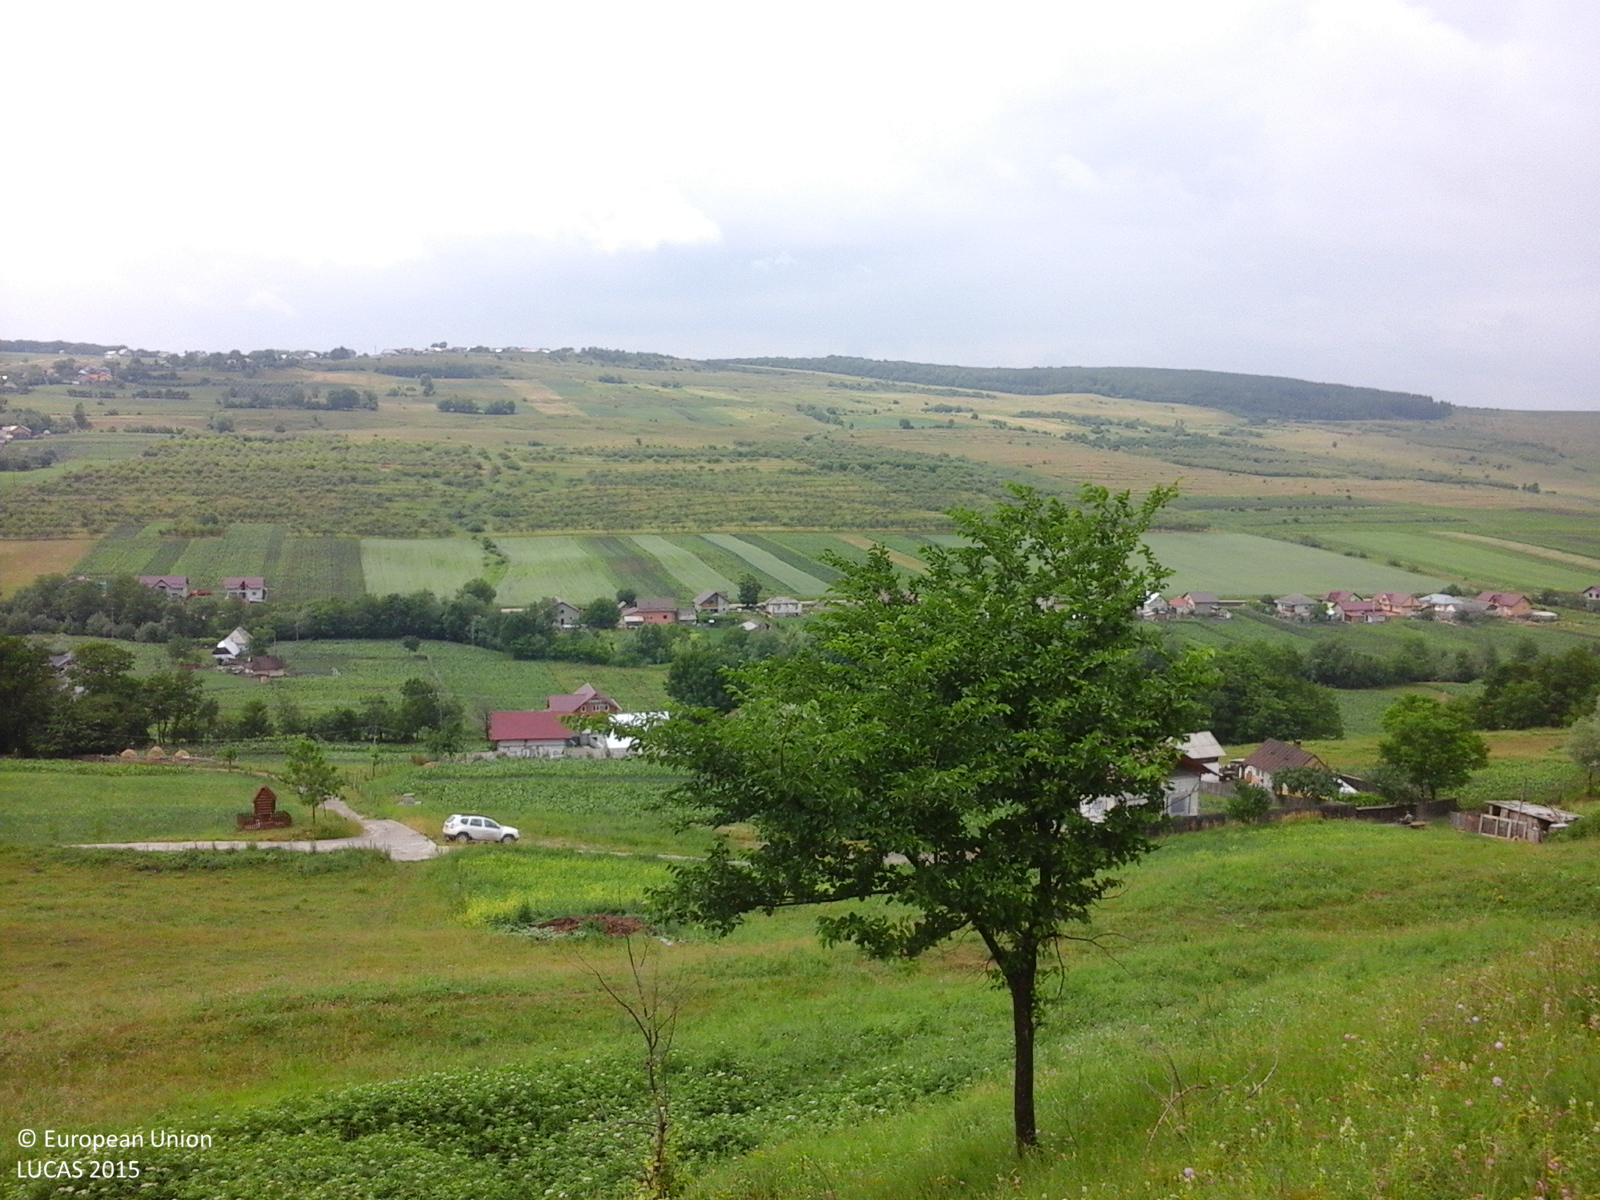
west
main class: Grassland
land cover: Grassland without tree/shrub cover
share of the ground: > 75 %
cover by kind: herbaceous plants 100 %
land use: Agriculture (excluding fallow land and kitchen gardens)
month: June
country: RO
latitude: 47.4281
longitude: 26.3782
